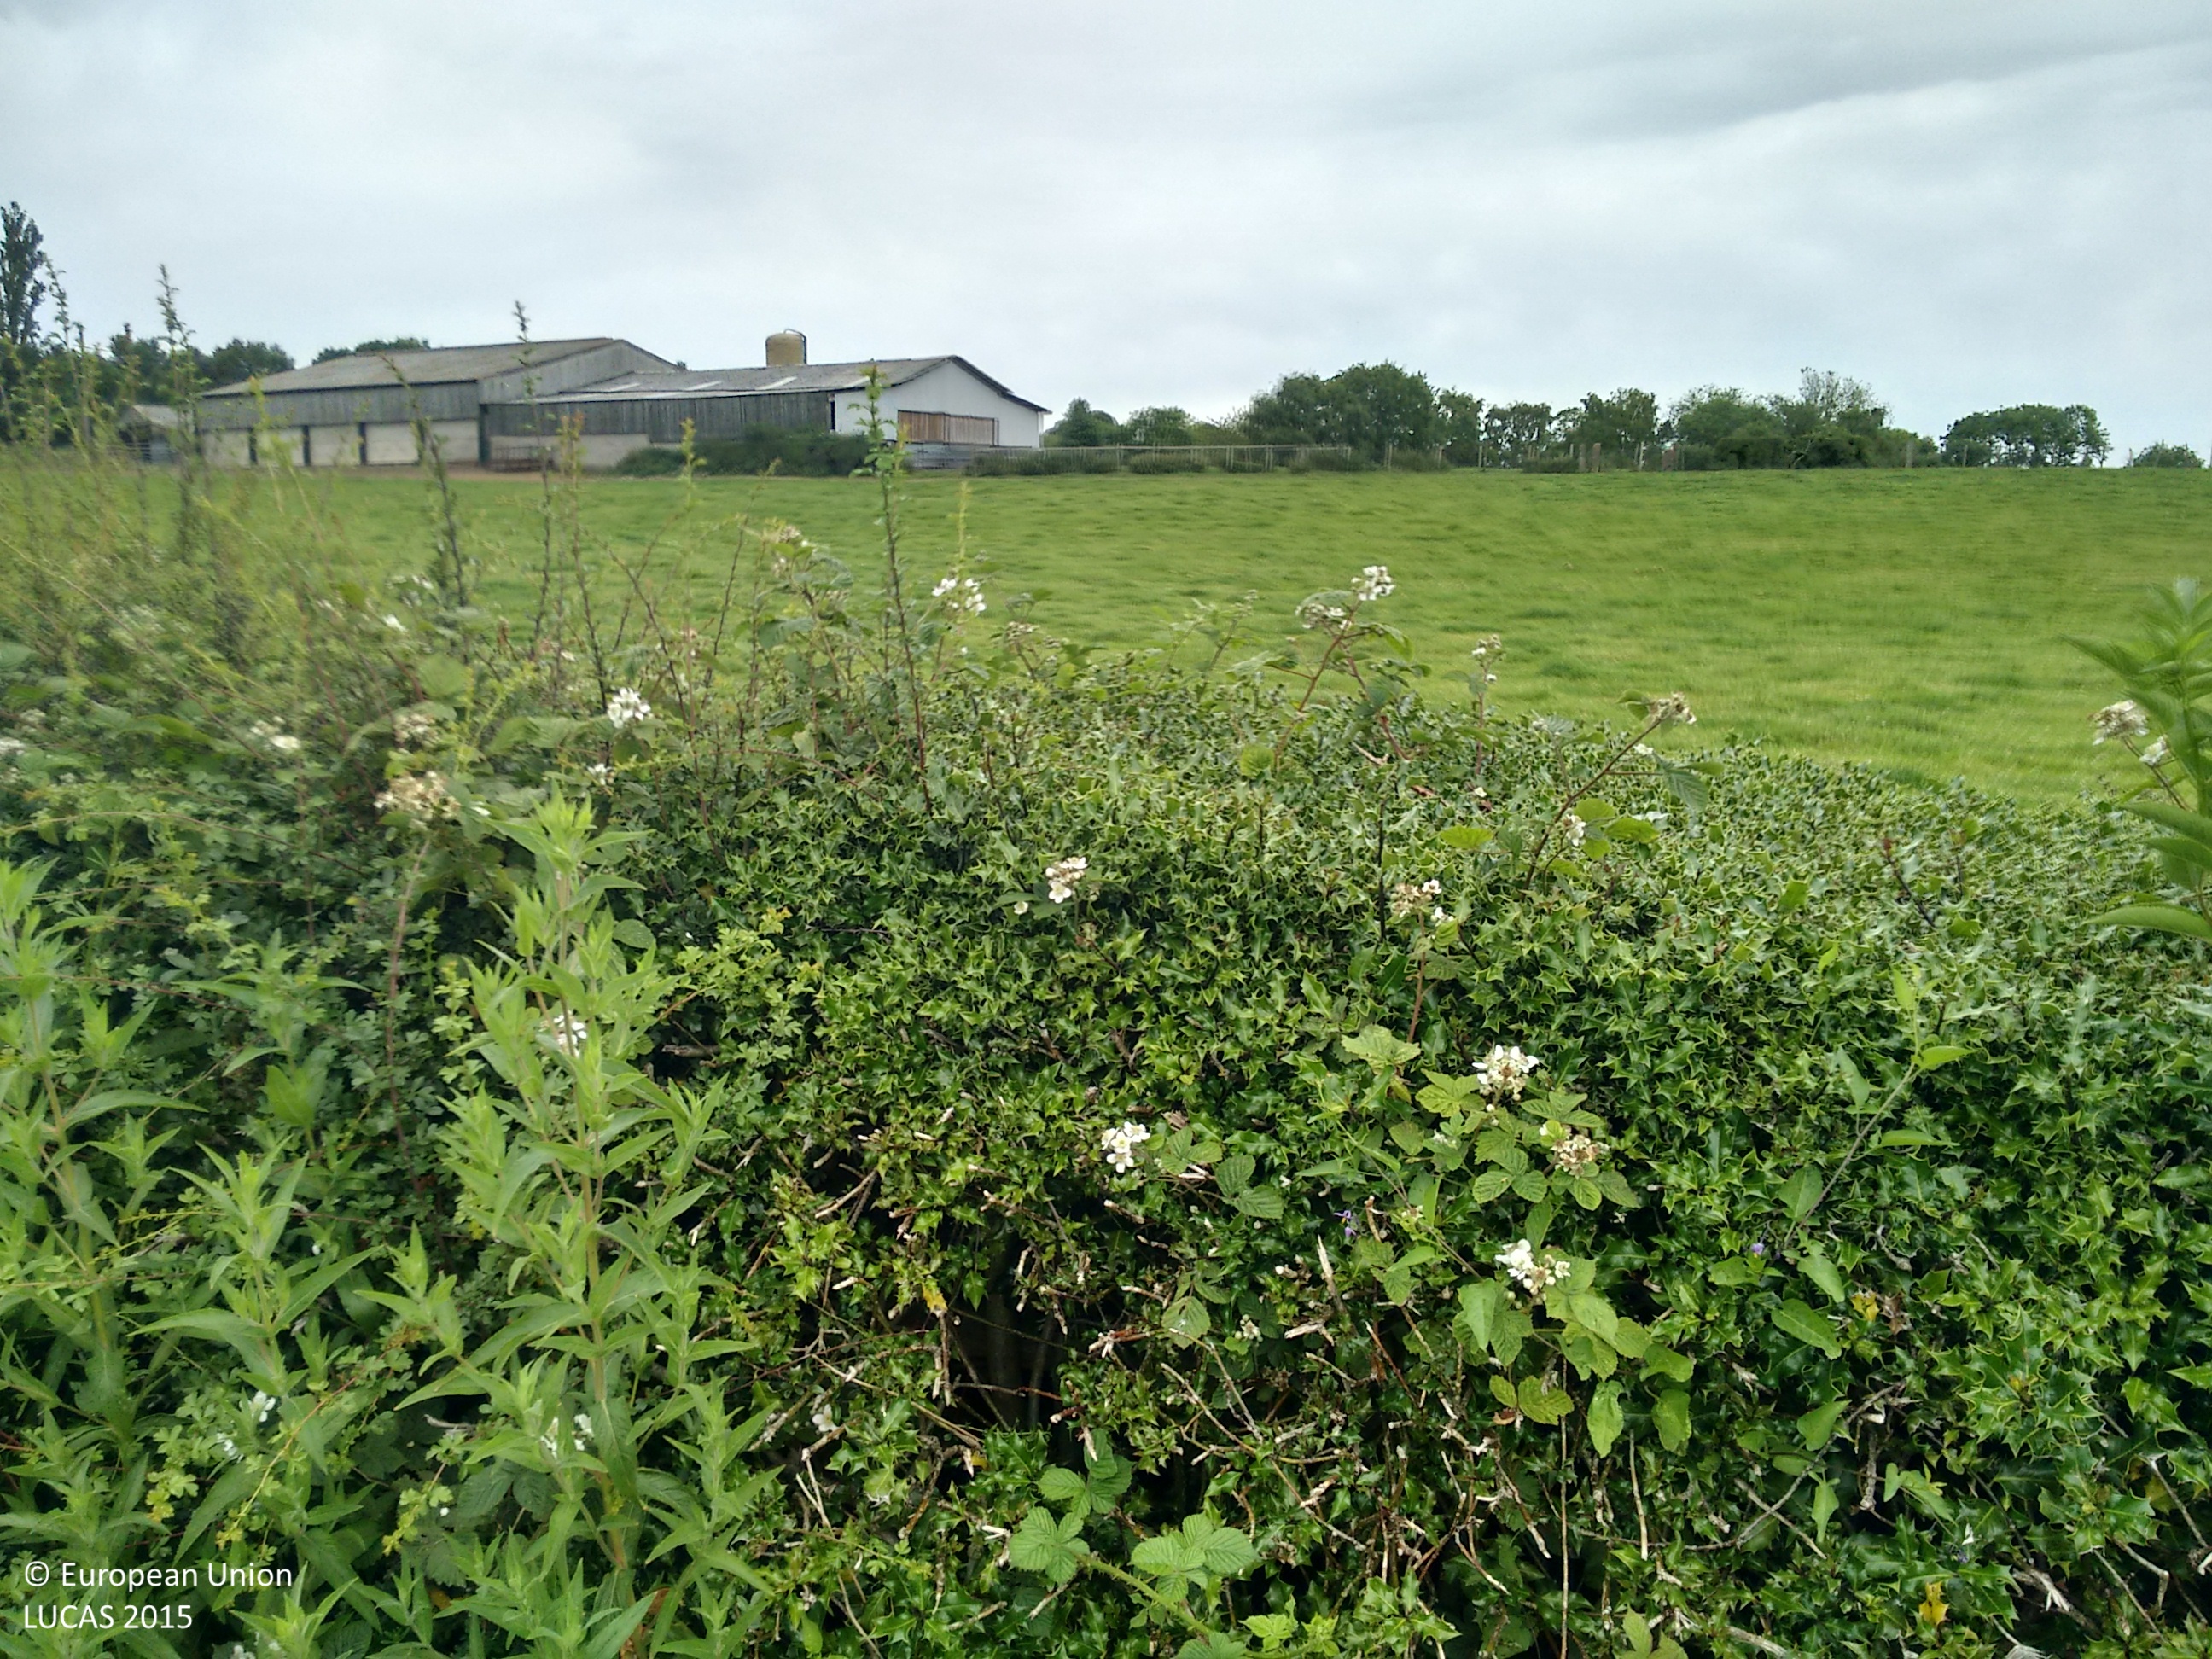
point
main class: Grassland
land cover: Grassland without tree/shrub cover
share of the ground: > 75 %
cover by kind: herbaceous plants 100 %
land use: Agriculture (excluding fallow land and kitchen gardens)
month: July
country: GB
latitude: 53.1113
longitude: -1.4483
